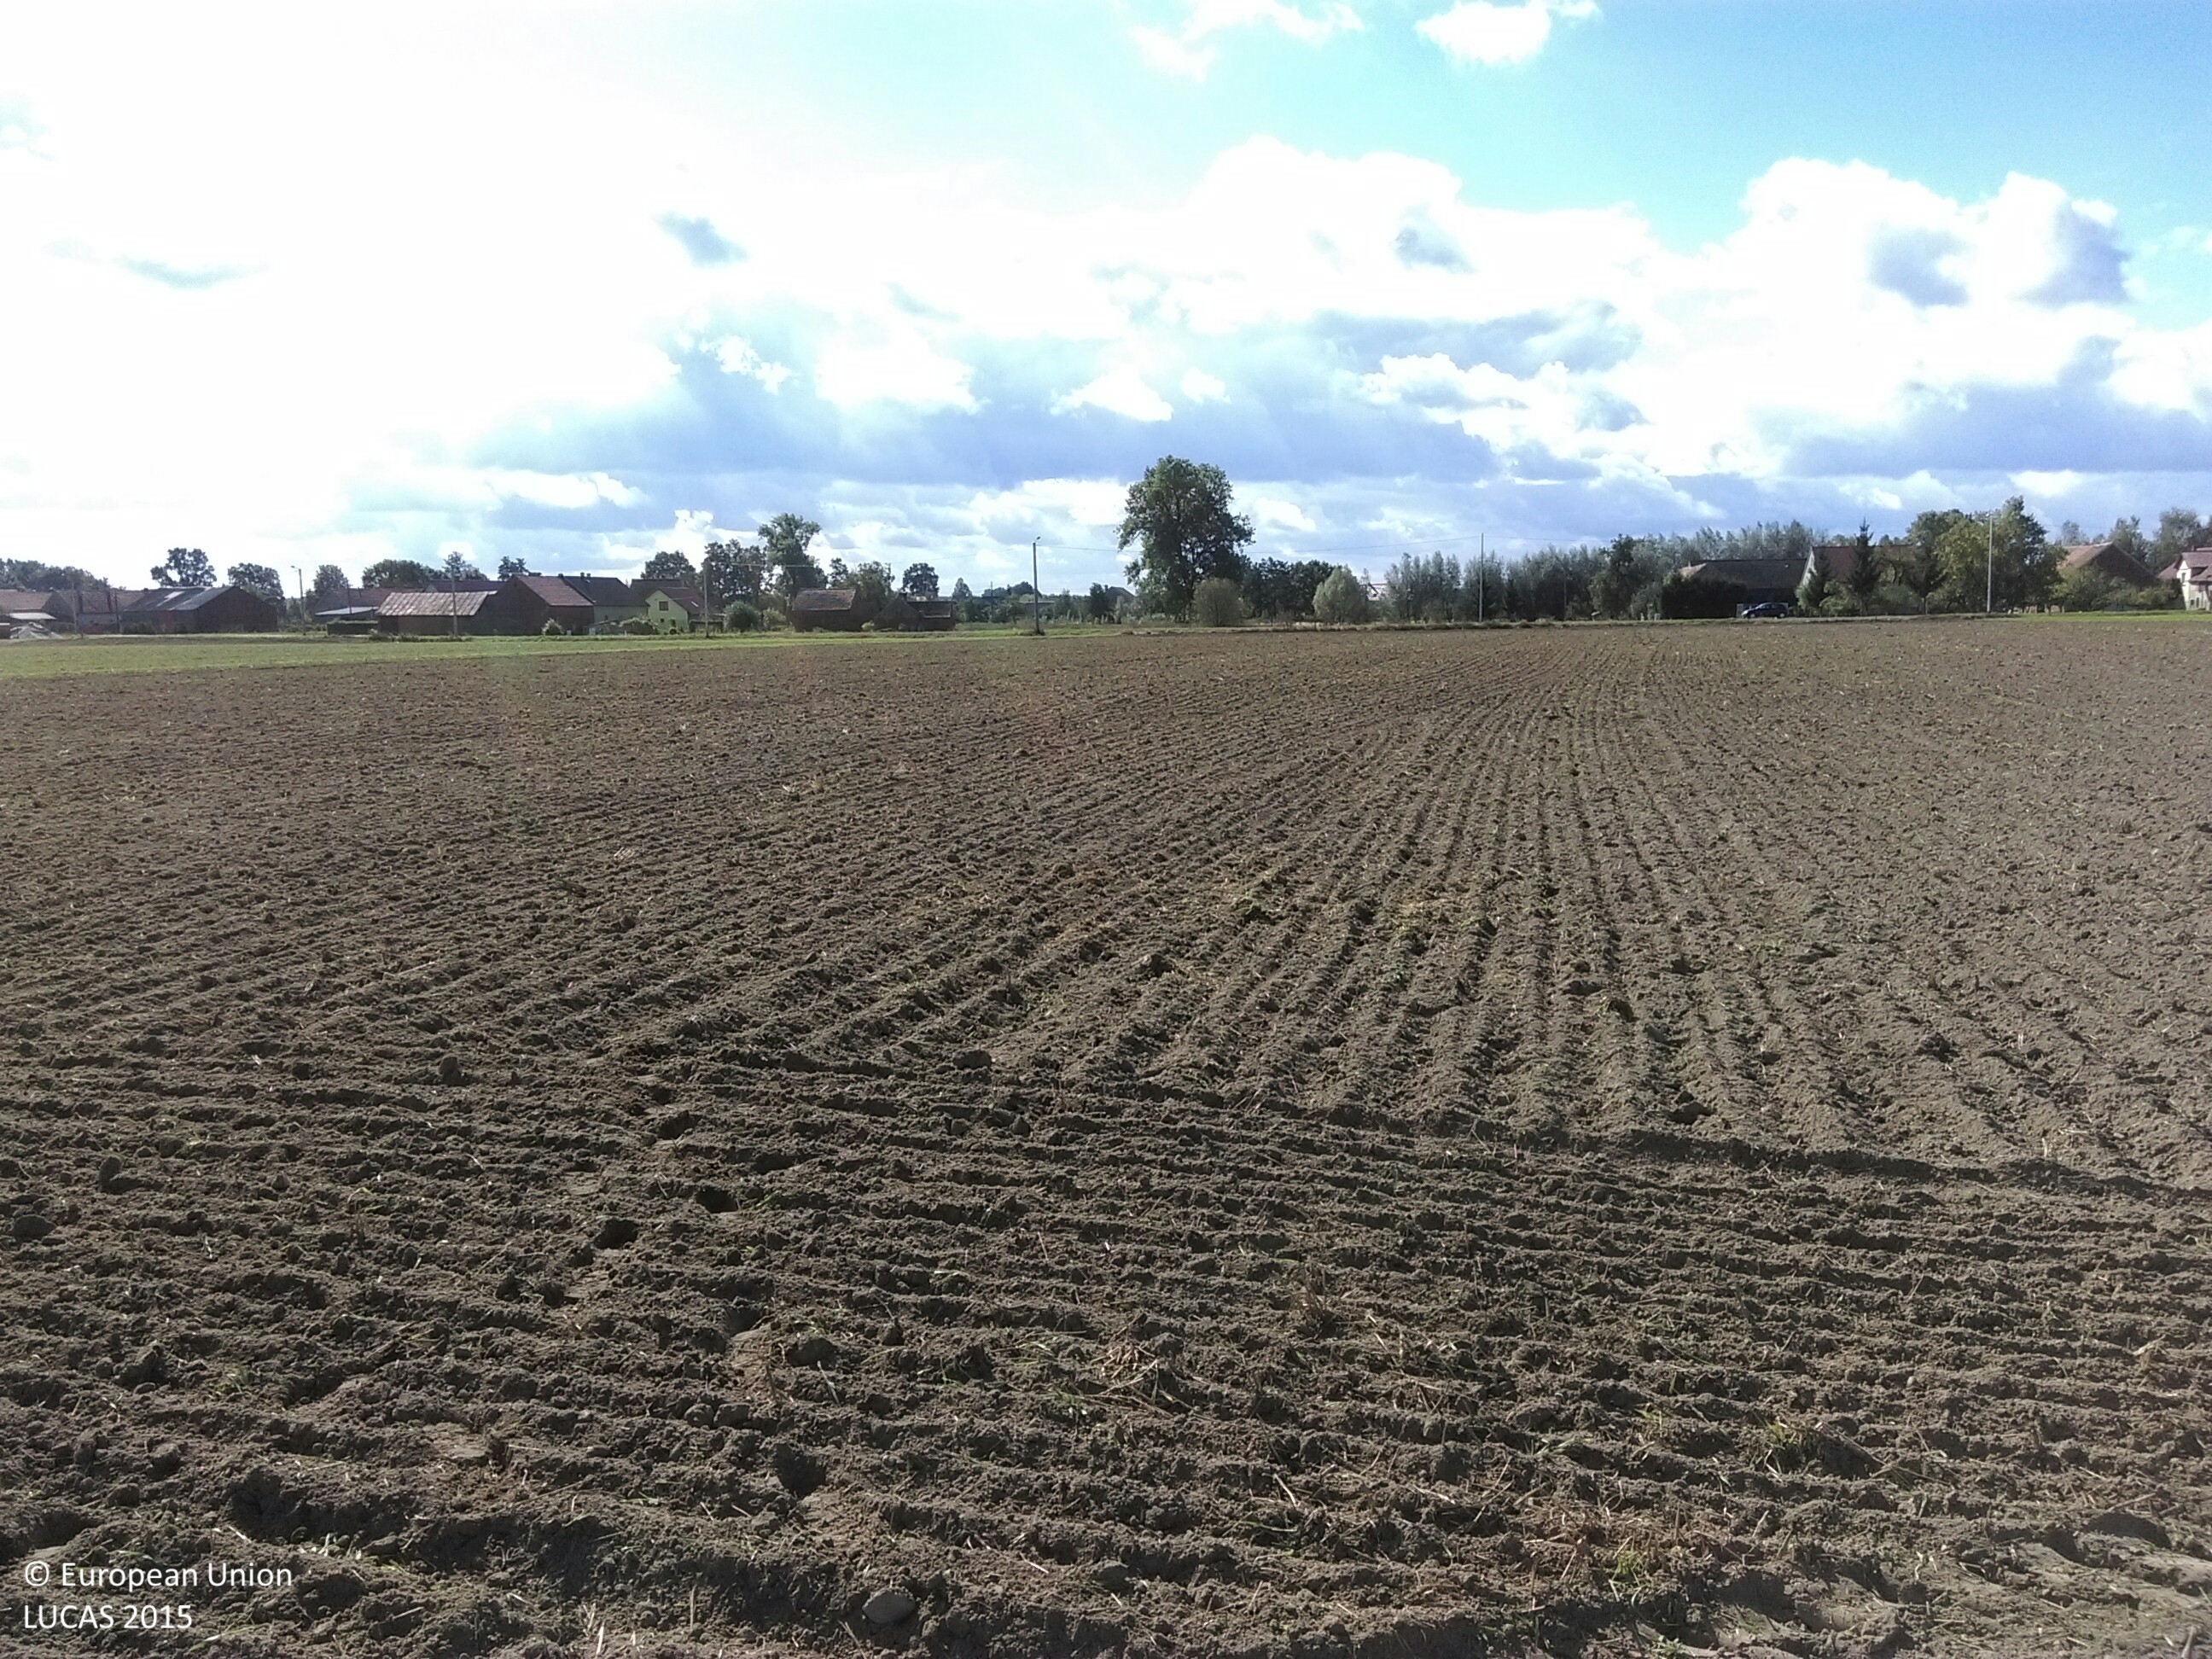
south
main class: Cropland
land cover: Rye
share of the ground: < 10 %
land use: Agriculture (excluding fallow land and kitchen gardens)
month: September
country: PL
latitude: 51.6066
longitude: 15.7663
